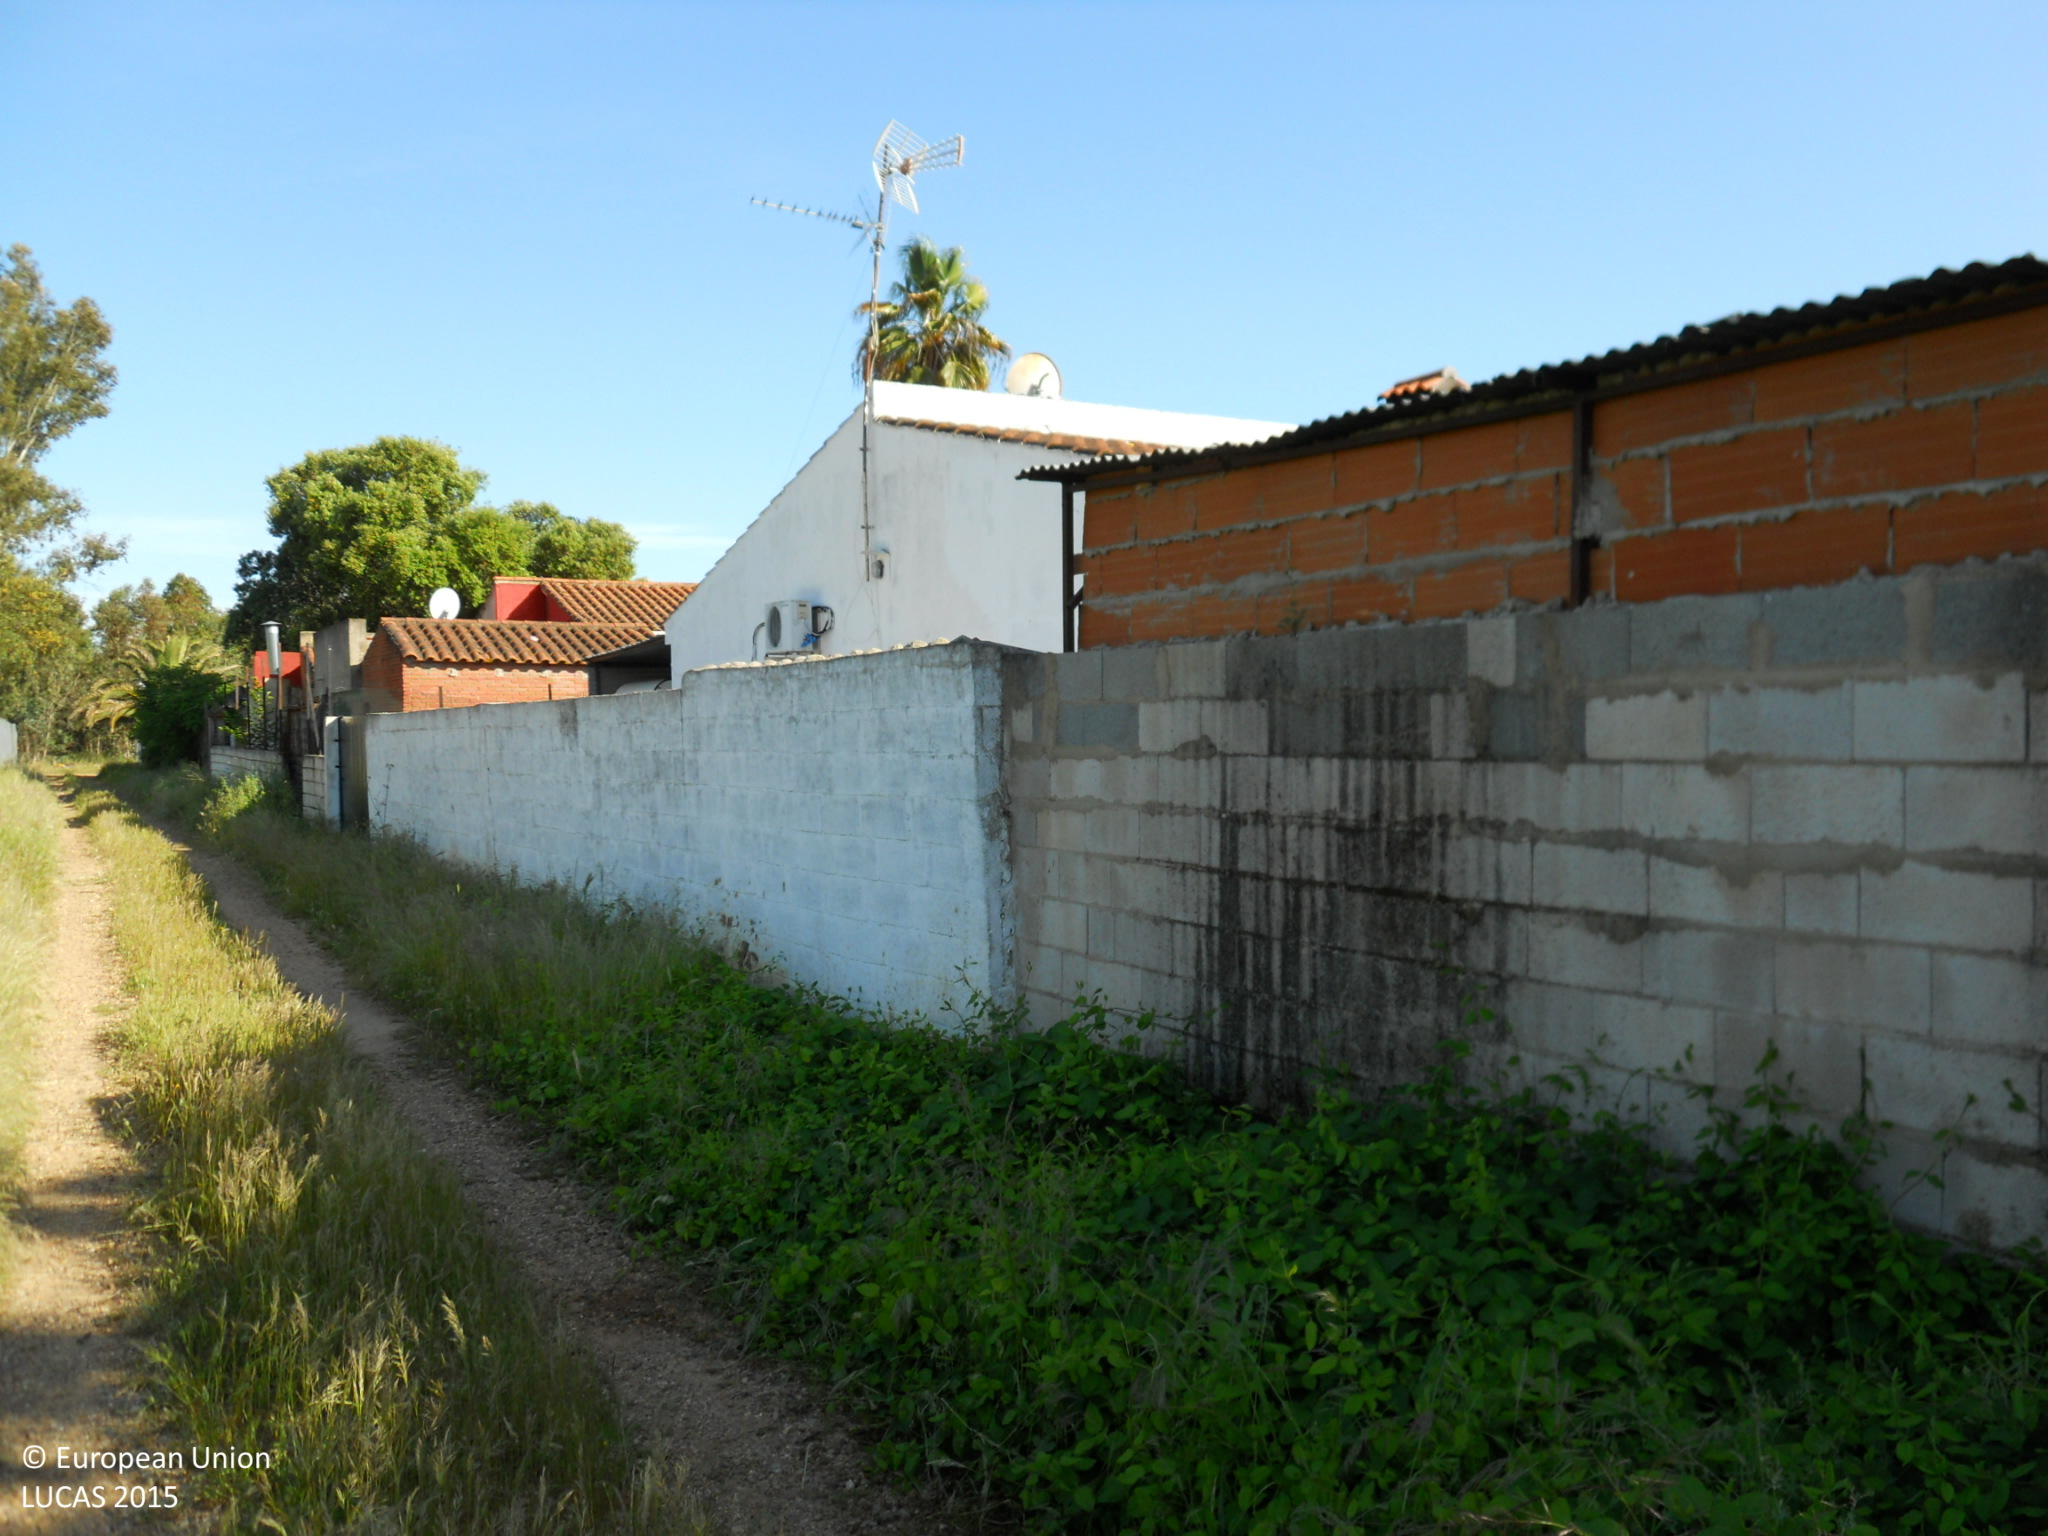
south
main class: Shrubland
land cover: Shrubland with sparse tree cover
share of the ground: 50 - 75 %
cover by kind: shrubs 50 %, herbaceous plants 45 %, broadleaved forest trees 5 %
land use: Forestry
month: April
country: ES
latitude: 38.9934
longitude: -6.8922
